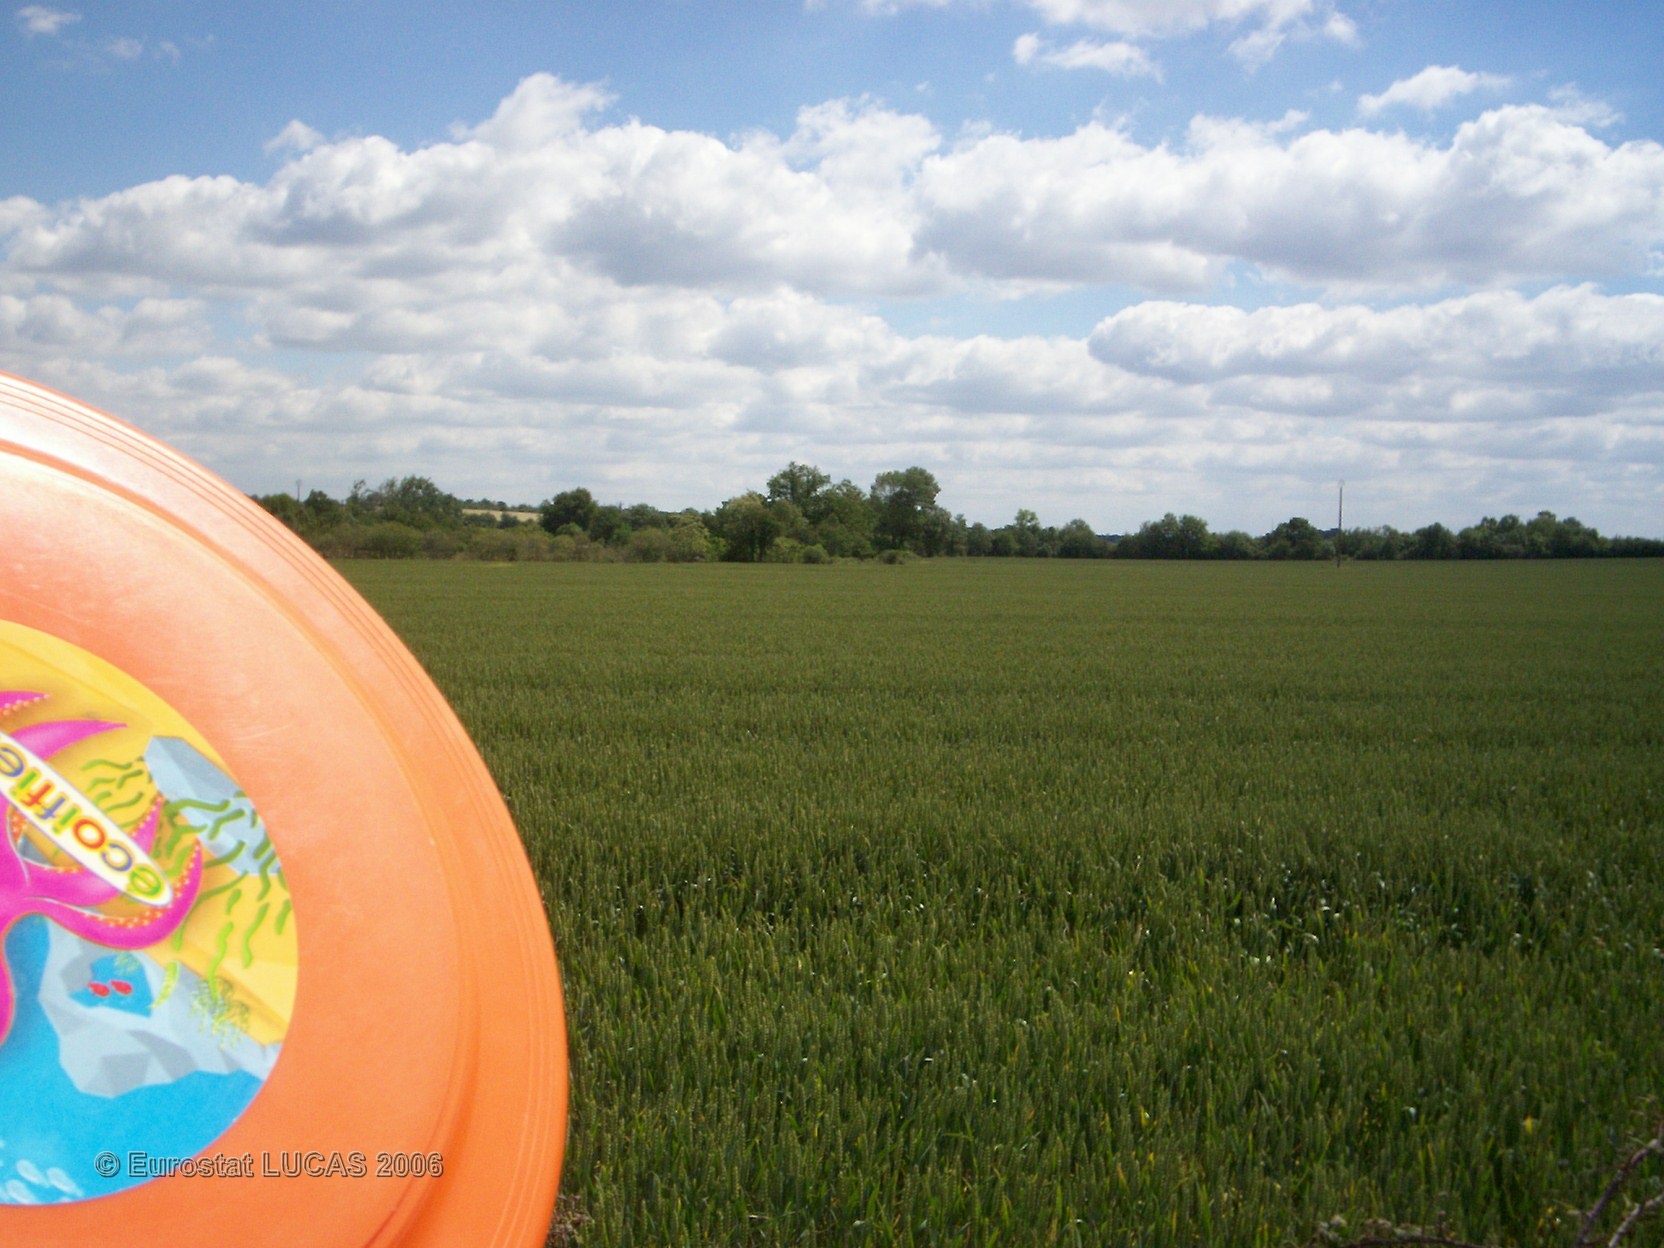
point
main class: Cropland
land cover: Common wheat
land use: Agriculture (excluding fallow land and kitchen gardens)
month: May
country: FR
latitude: 47.4954
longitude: -1.1219
